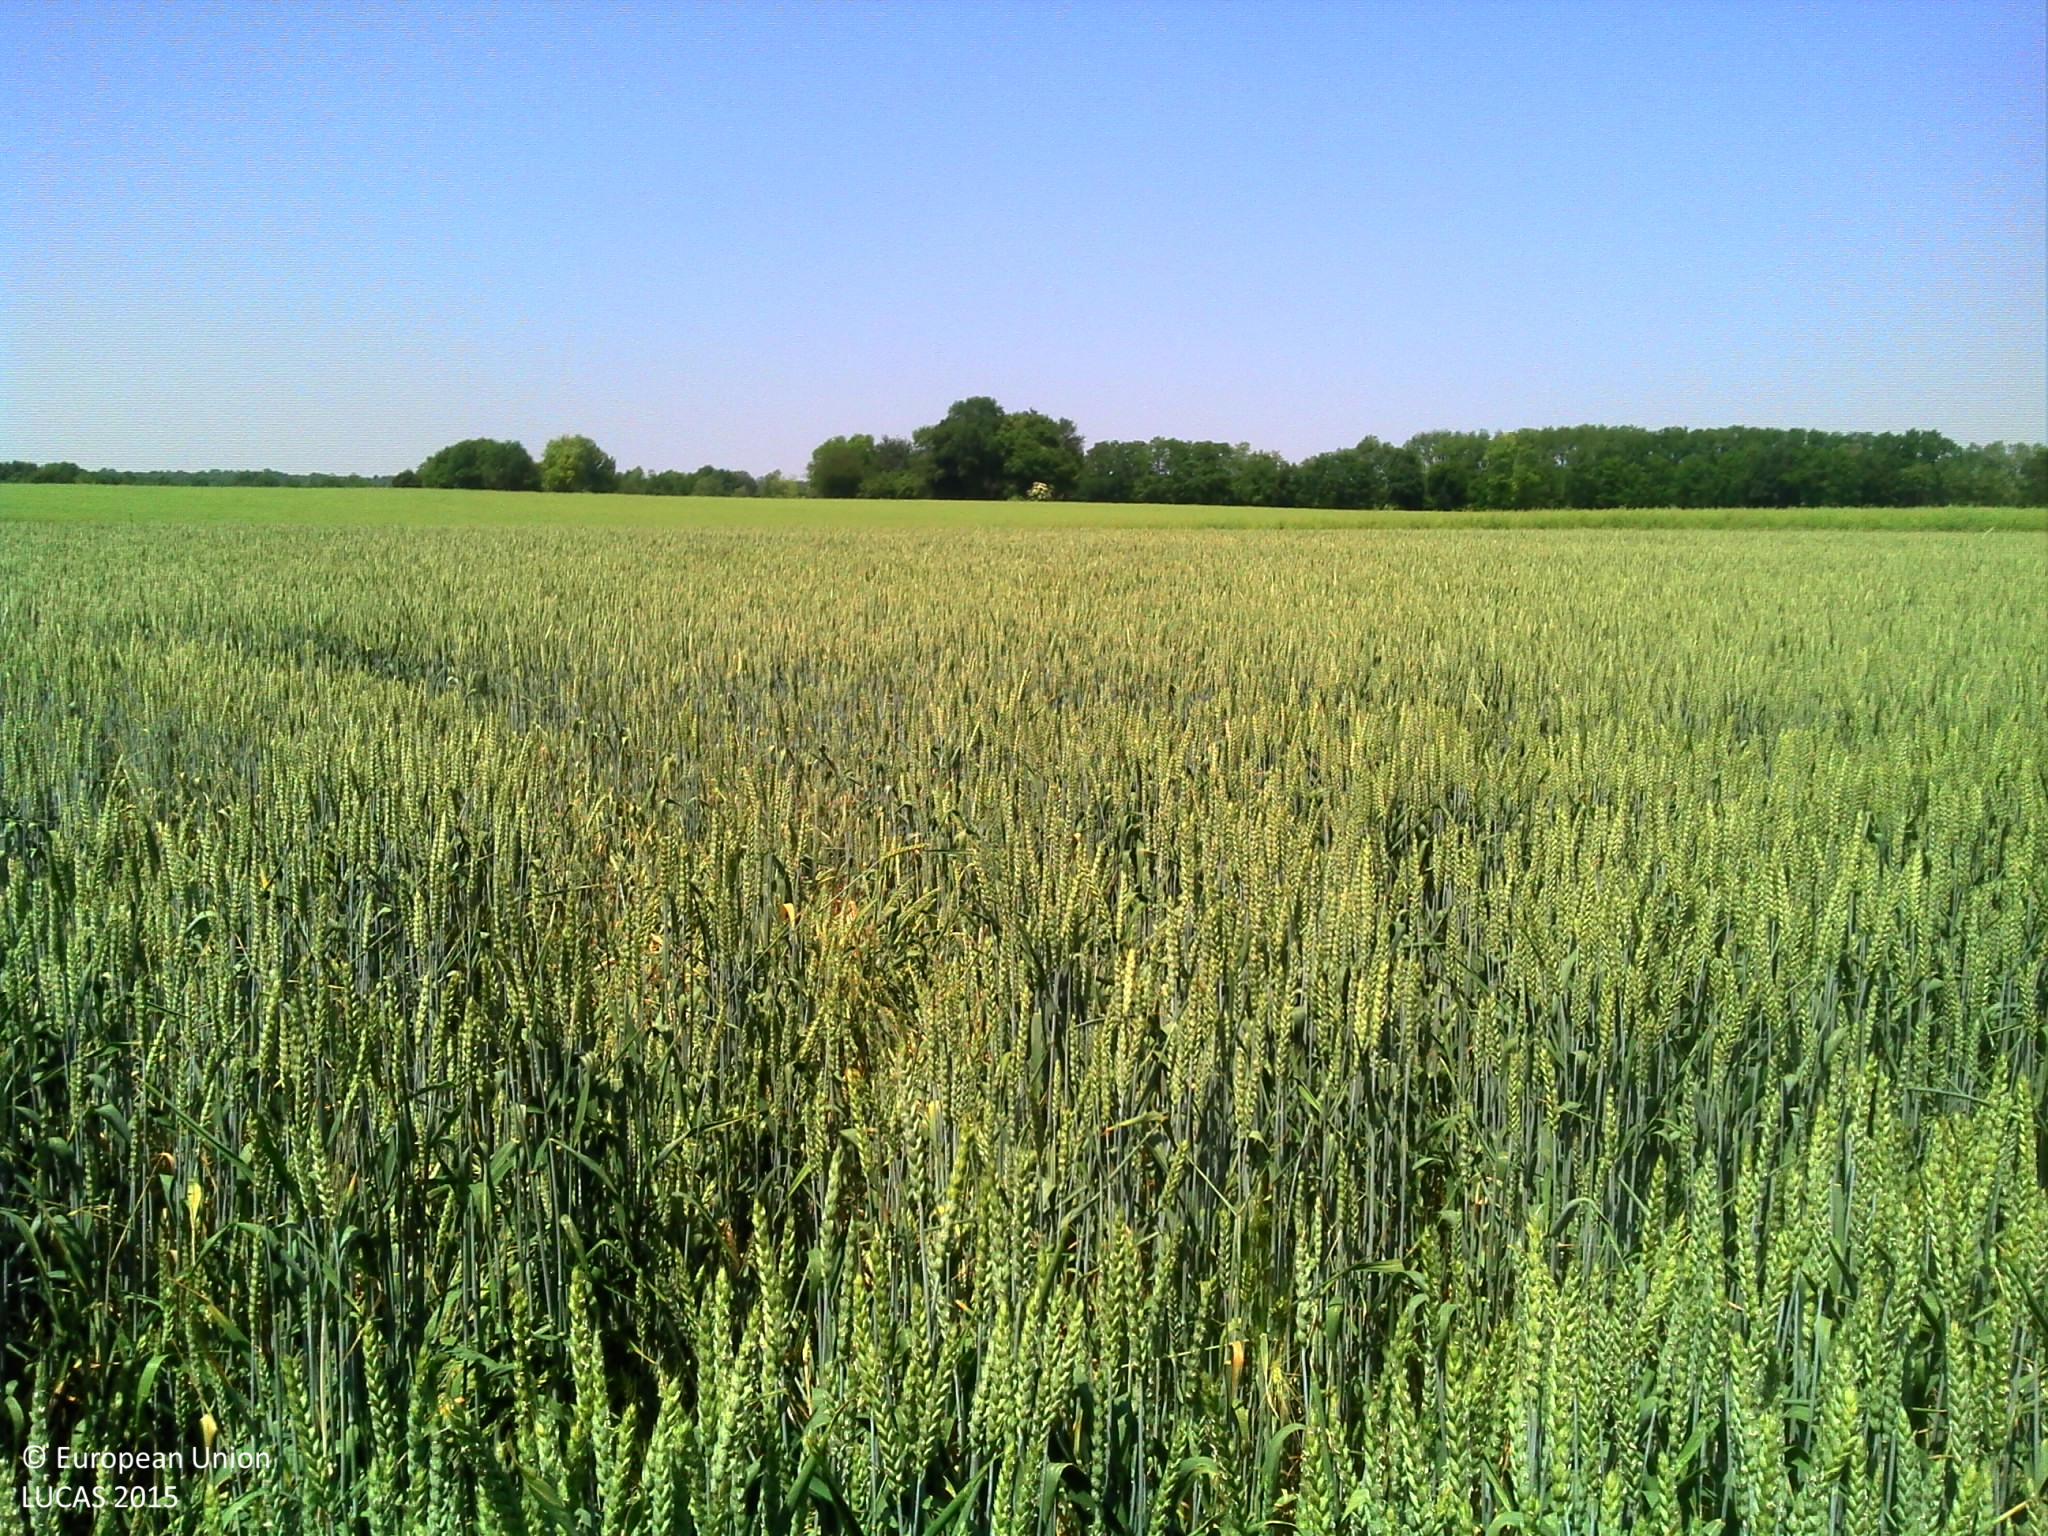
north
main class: Cropland
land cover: Common wheat
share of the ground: > 75 %
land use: Agriculture (excluding fallow land and kitchen gardens)
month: June
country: FR
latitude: 47.5829
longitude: 6.2386
